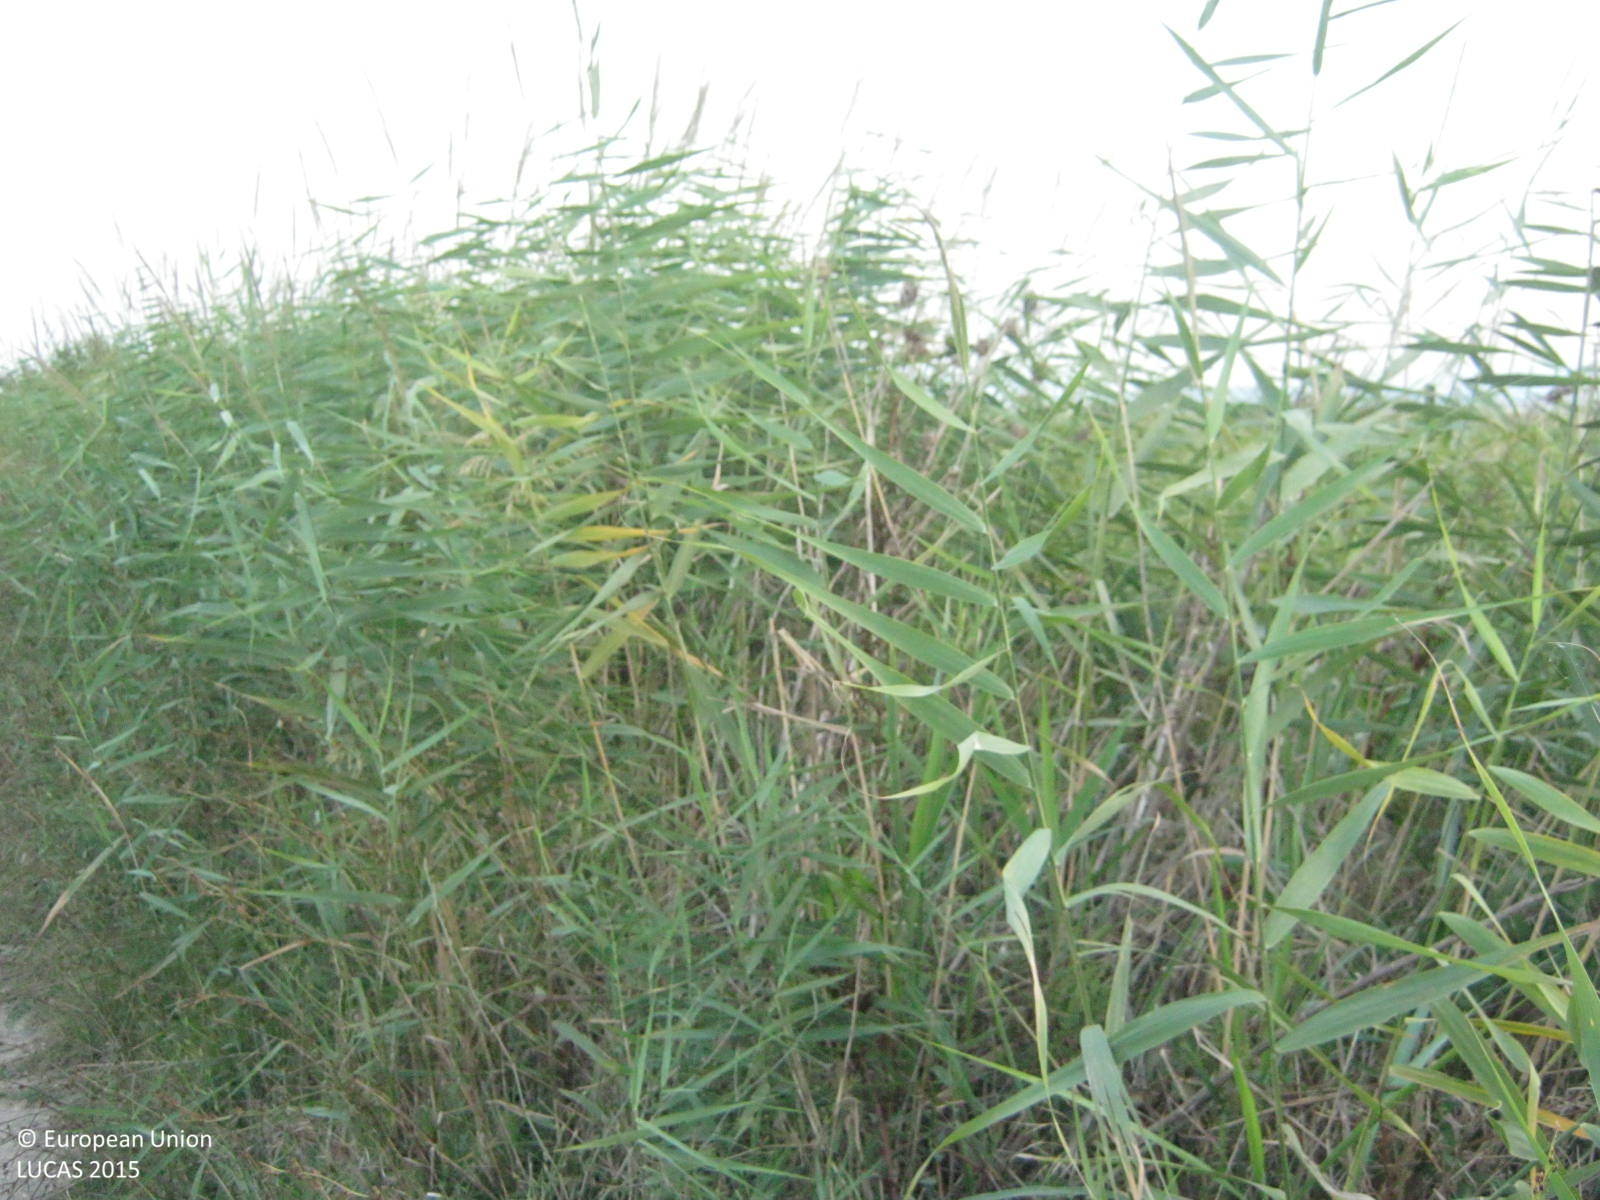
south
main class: Cropland
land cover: Cotton
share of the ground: > 75 %
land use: Agriculture (excluding fallow land and kitchen gardens)
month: August
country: GR
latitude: 40.6077
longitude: 22.5659
